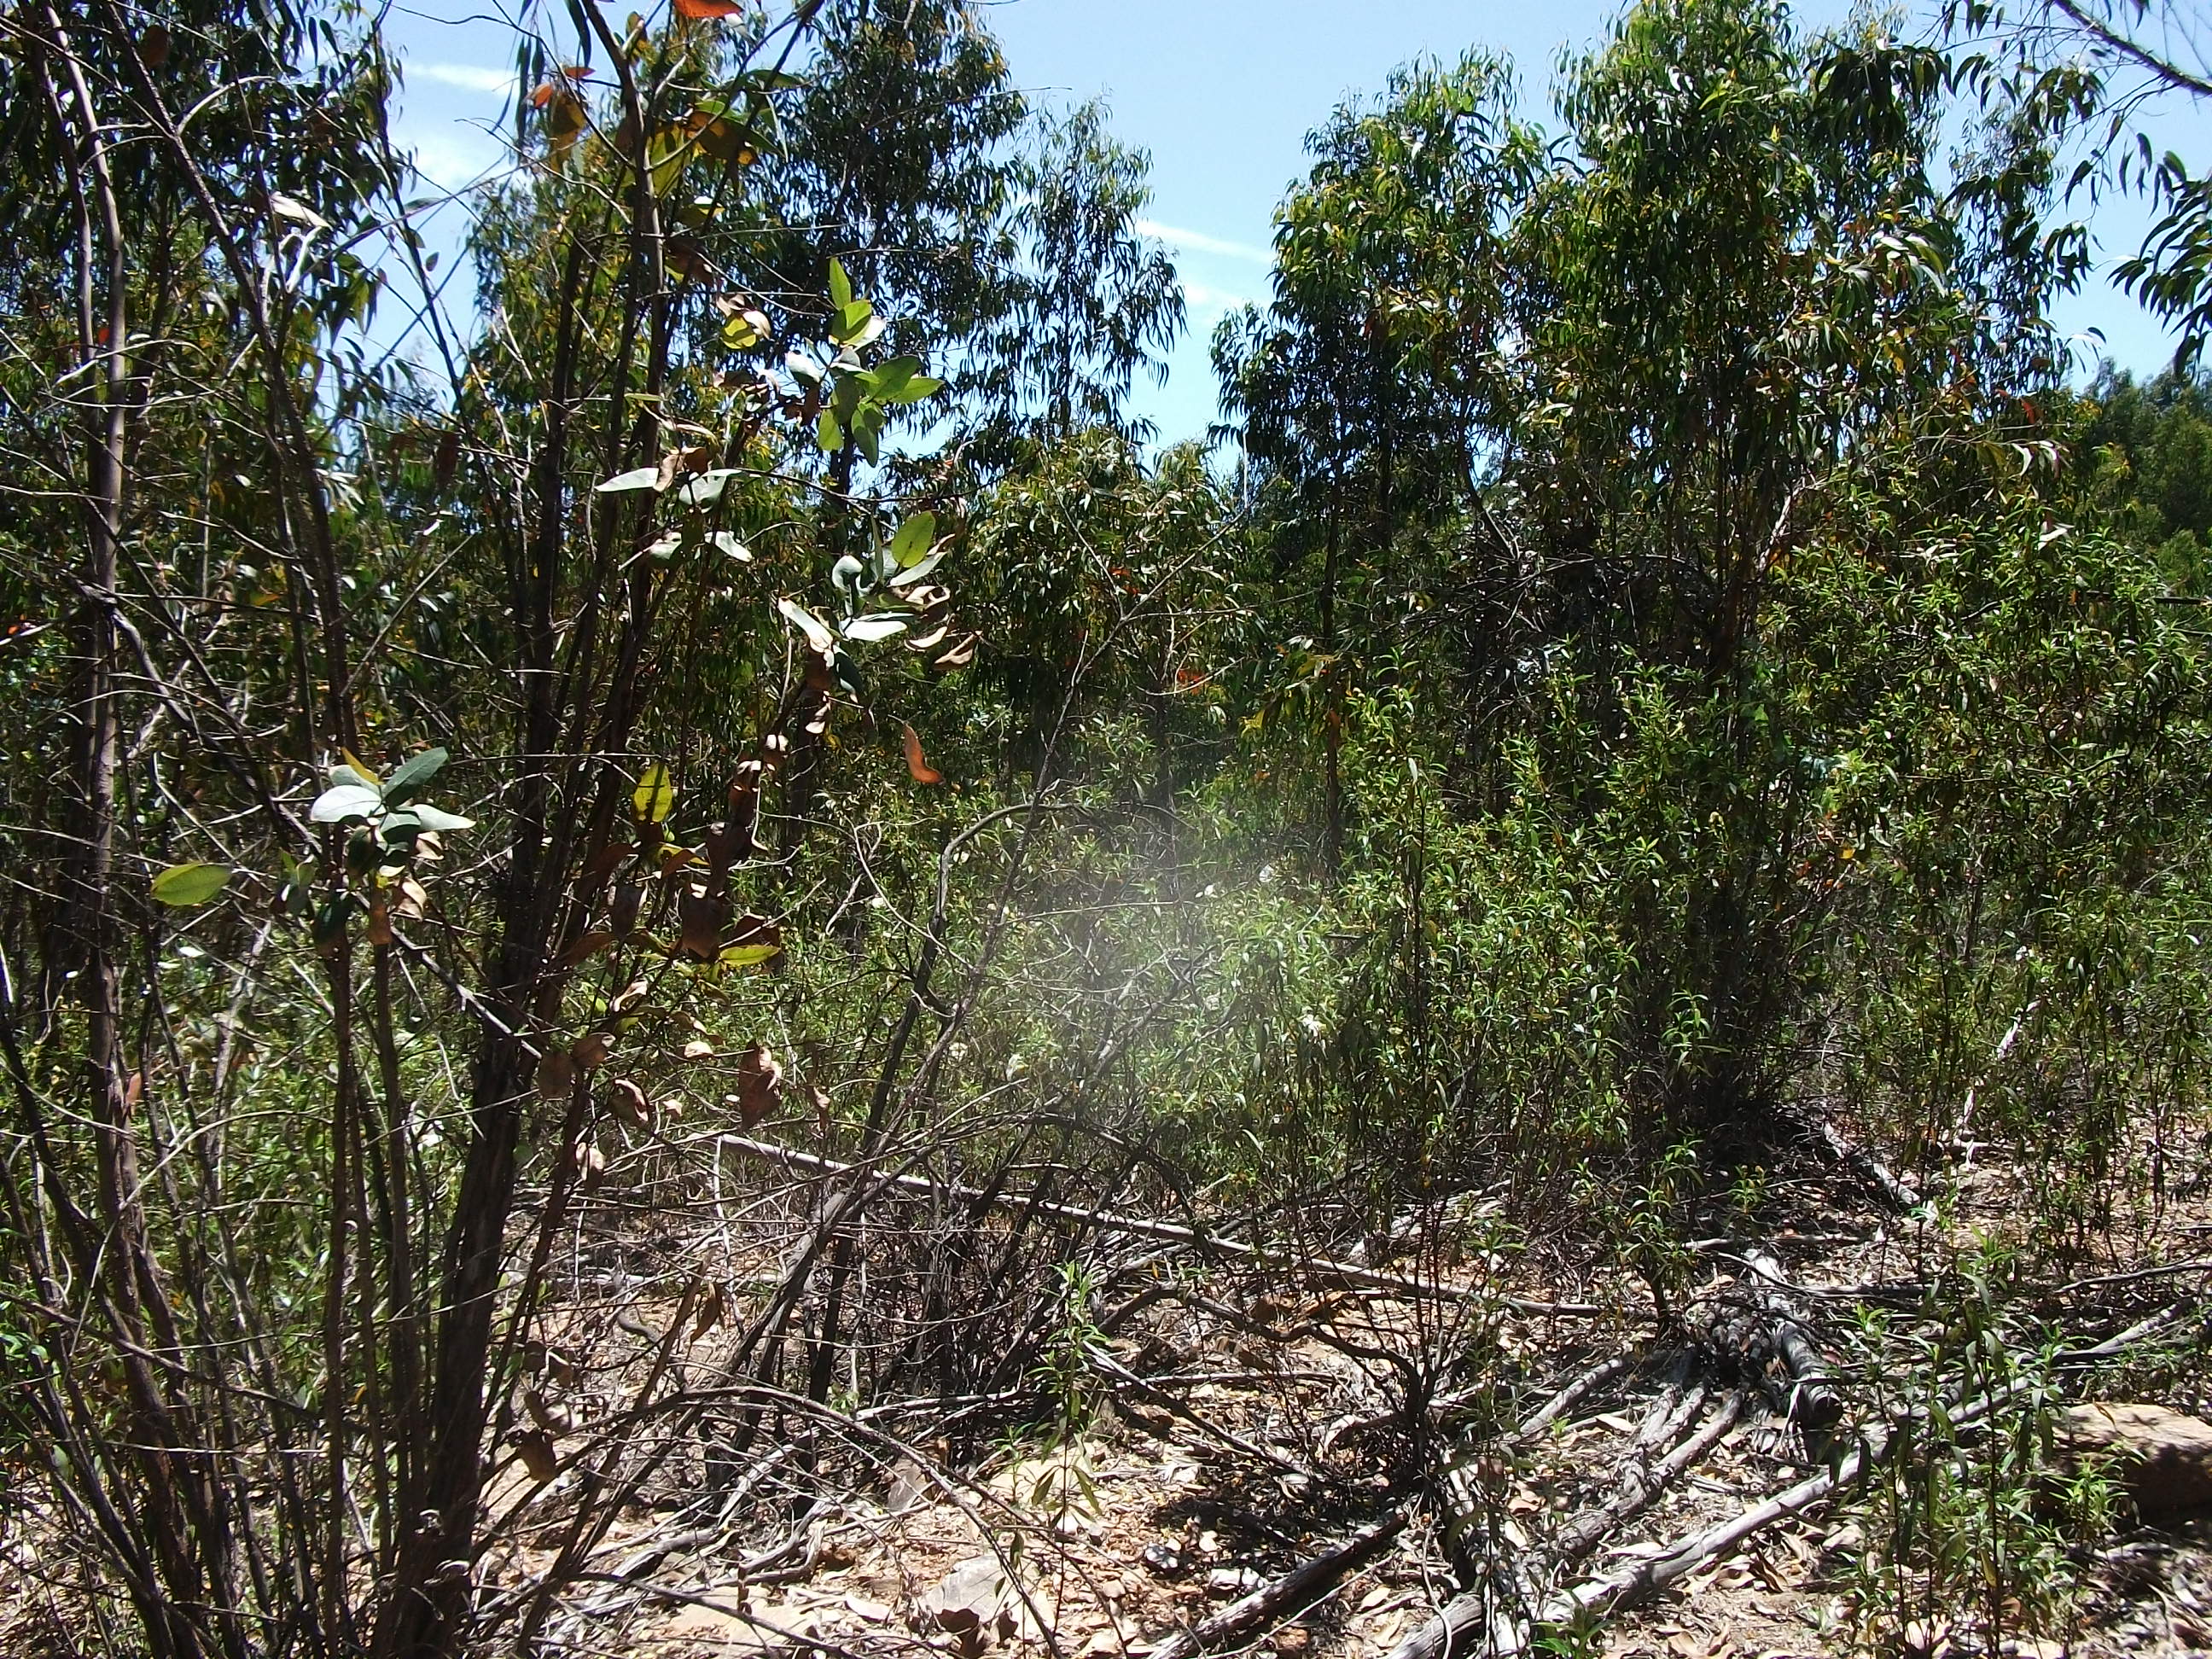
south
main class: Woodland
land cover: Broadleaved woodland
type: exotic forest
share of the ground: 50 - 75 %
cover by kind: broadleaved forest trees 60 %, shrubs 40 %
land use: Forestry
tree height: > 5 m
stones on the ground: 25 - 50 %
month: May
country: ES
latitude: 37.9216
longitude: -7.1071
